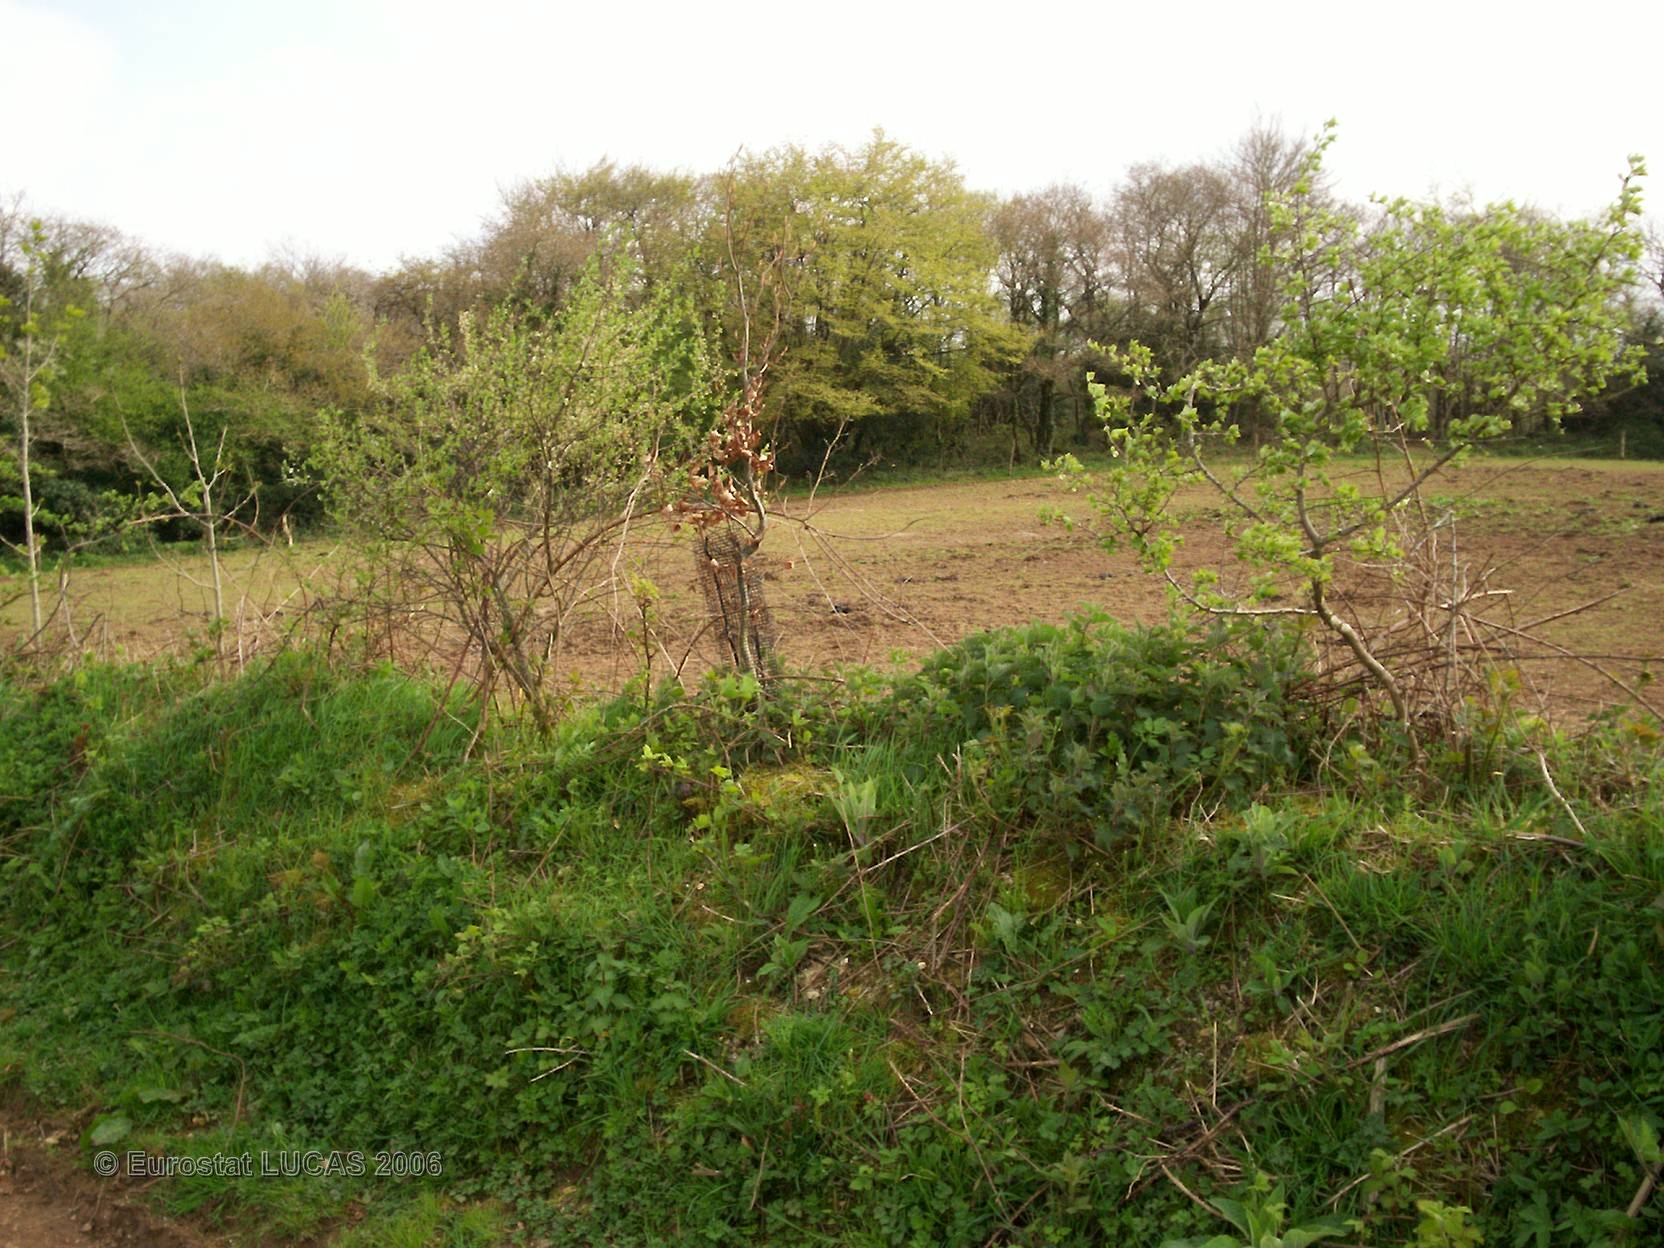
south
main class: Grassland
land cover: Grassland without tree/shrub cover
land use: Agriculture (excluding fallow land and kitchen gardens)
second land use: Amenities, museums, leisure
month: April
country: FR
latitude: 48.3154
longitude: -3.9630
